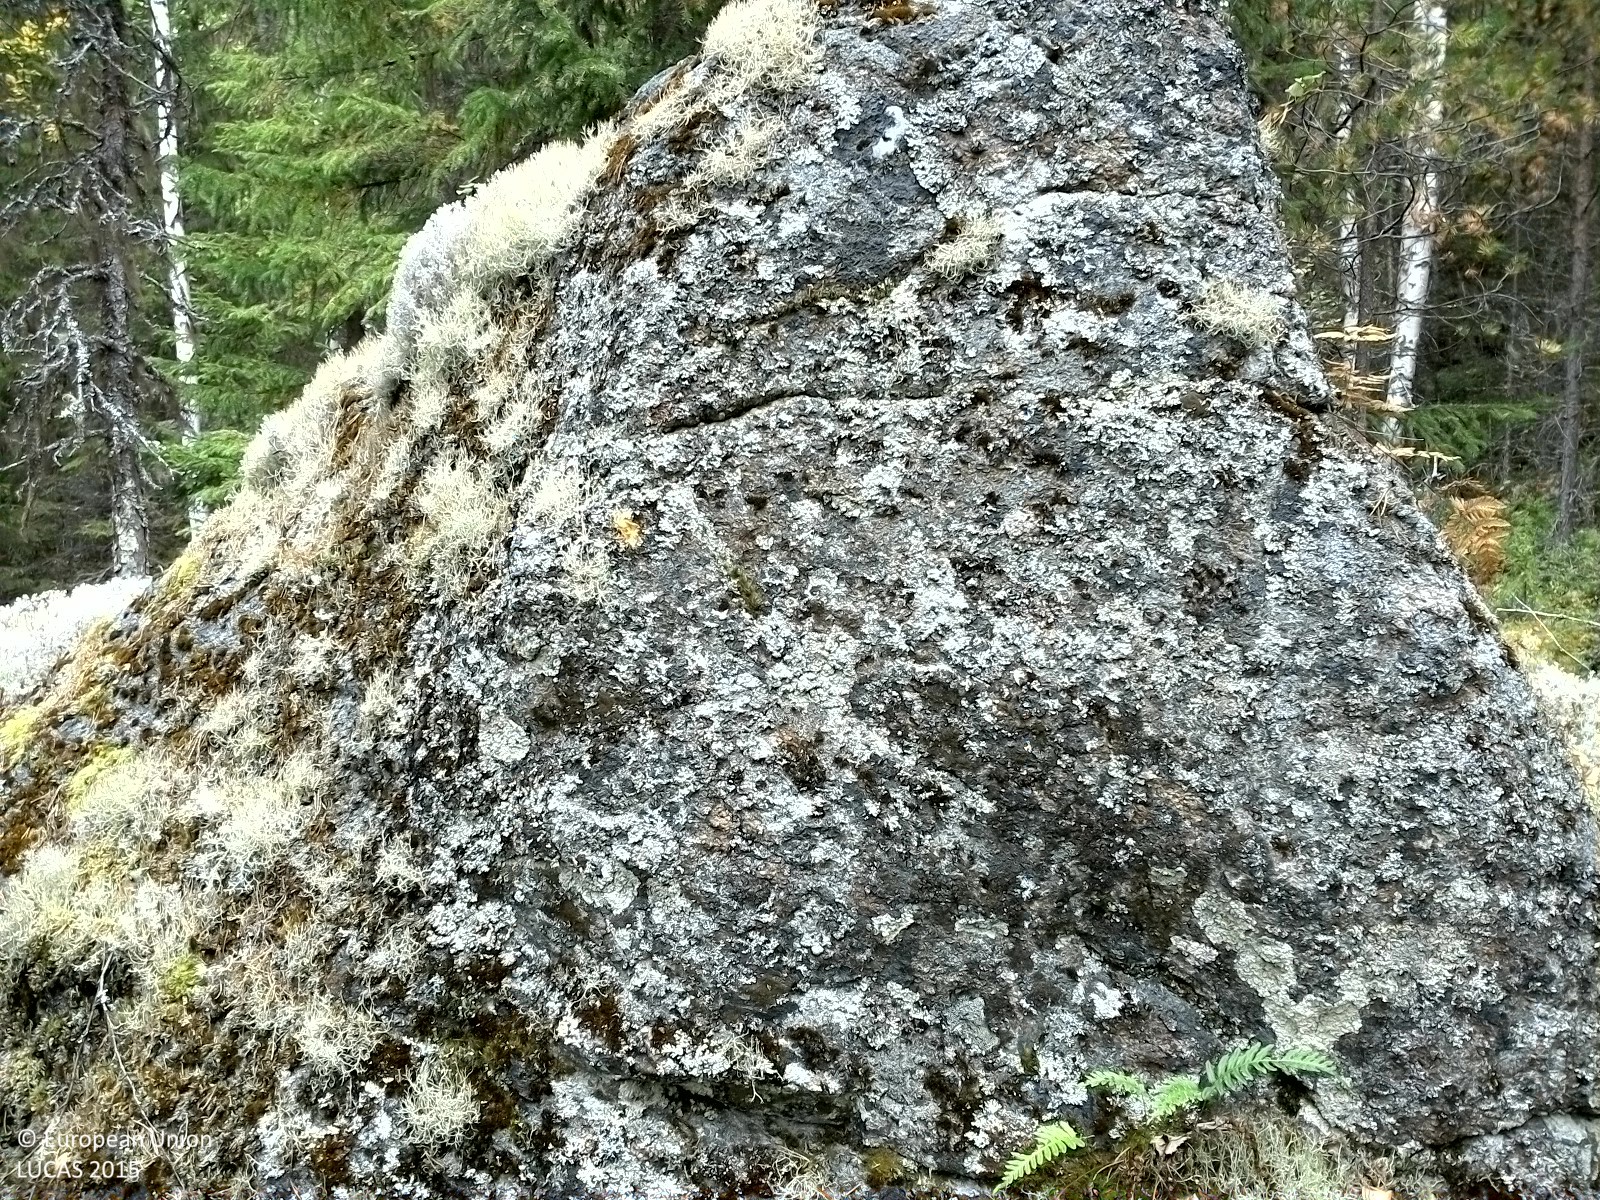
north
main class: Woodland
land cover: Spruce dominated mixed woodland
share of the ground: 50 - 75 %
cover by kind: coniferous forest trees 40 %, broadleaved forest trees 20 %, shrubs 20 %, lichens and mosses 20 %
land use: Forestry
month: September
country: SE
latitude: 62.4909
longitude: 16.4805
